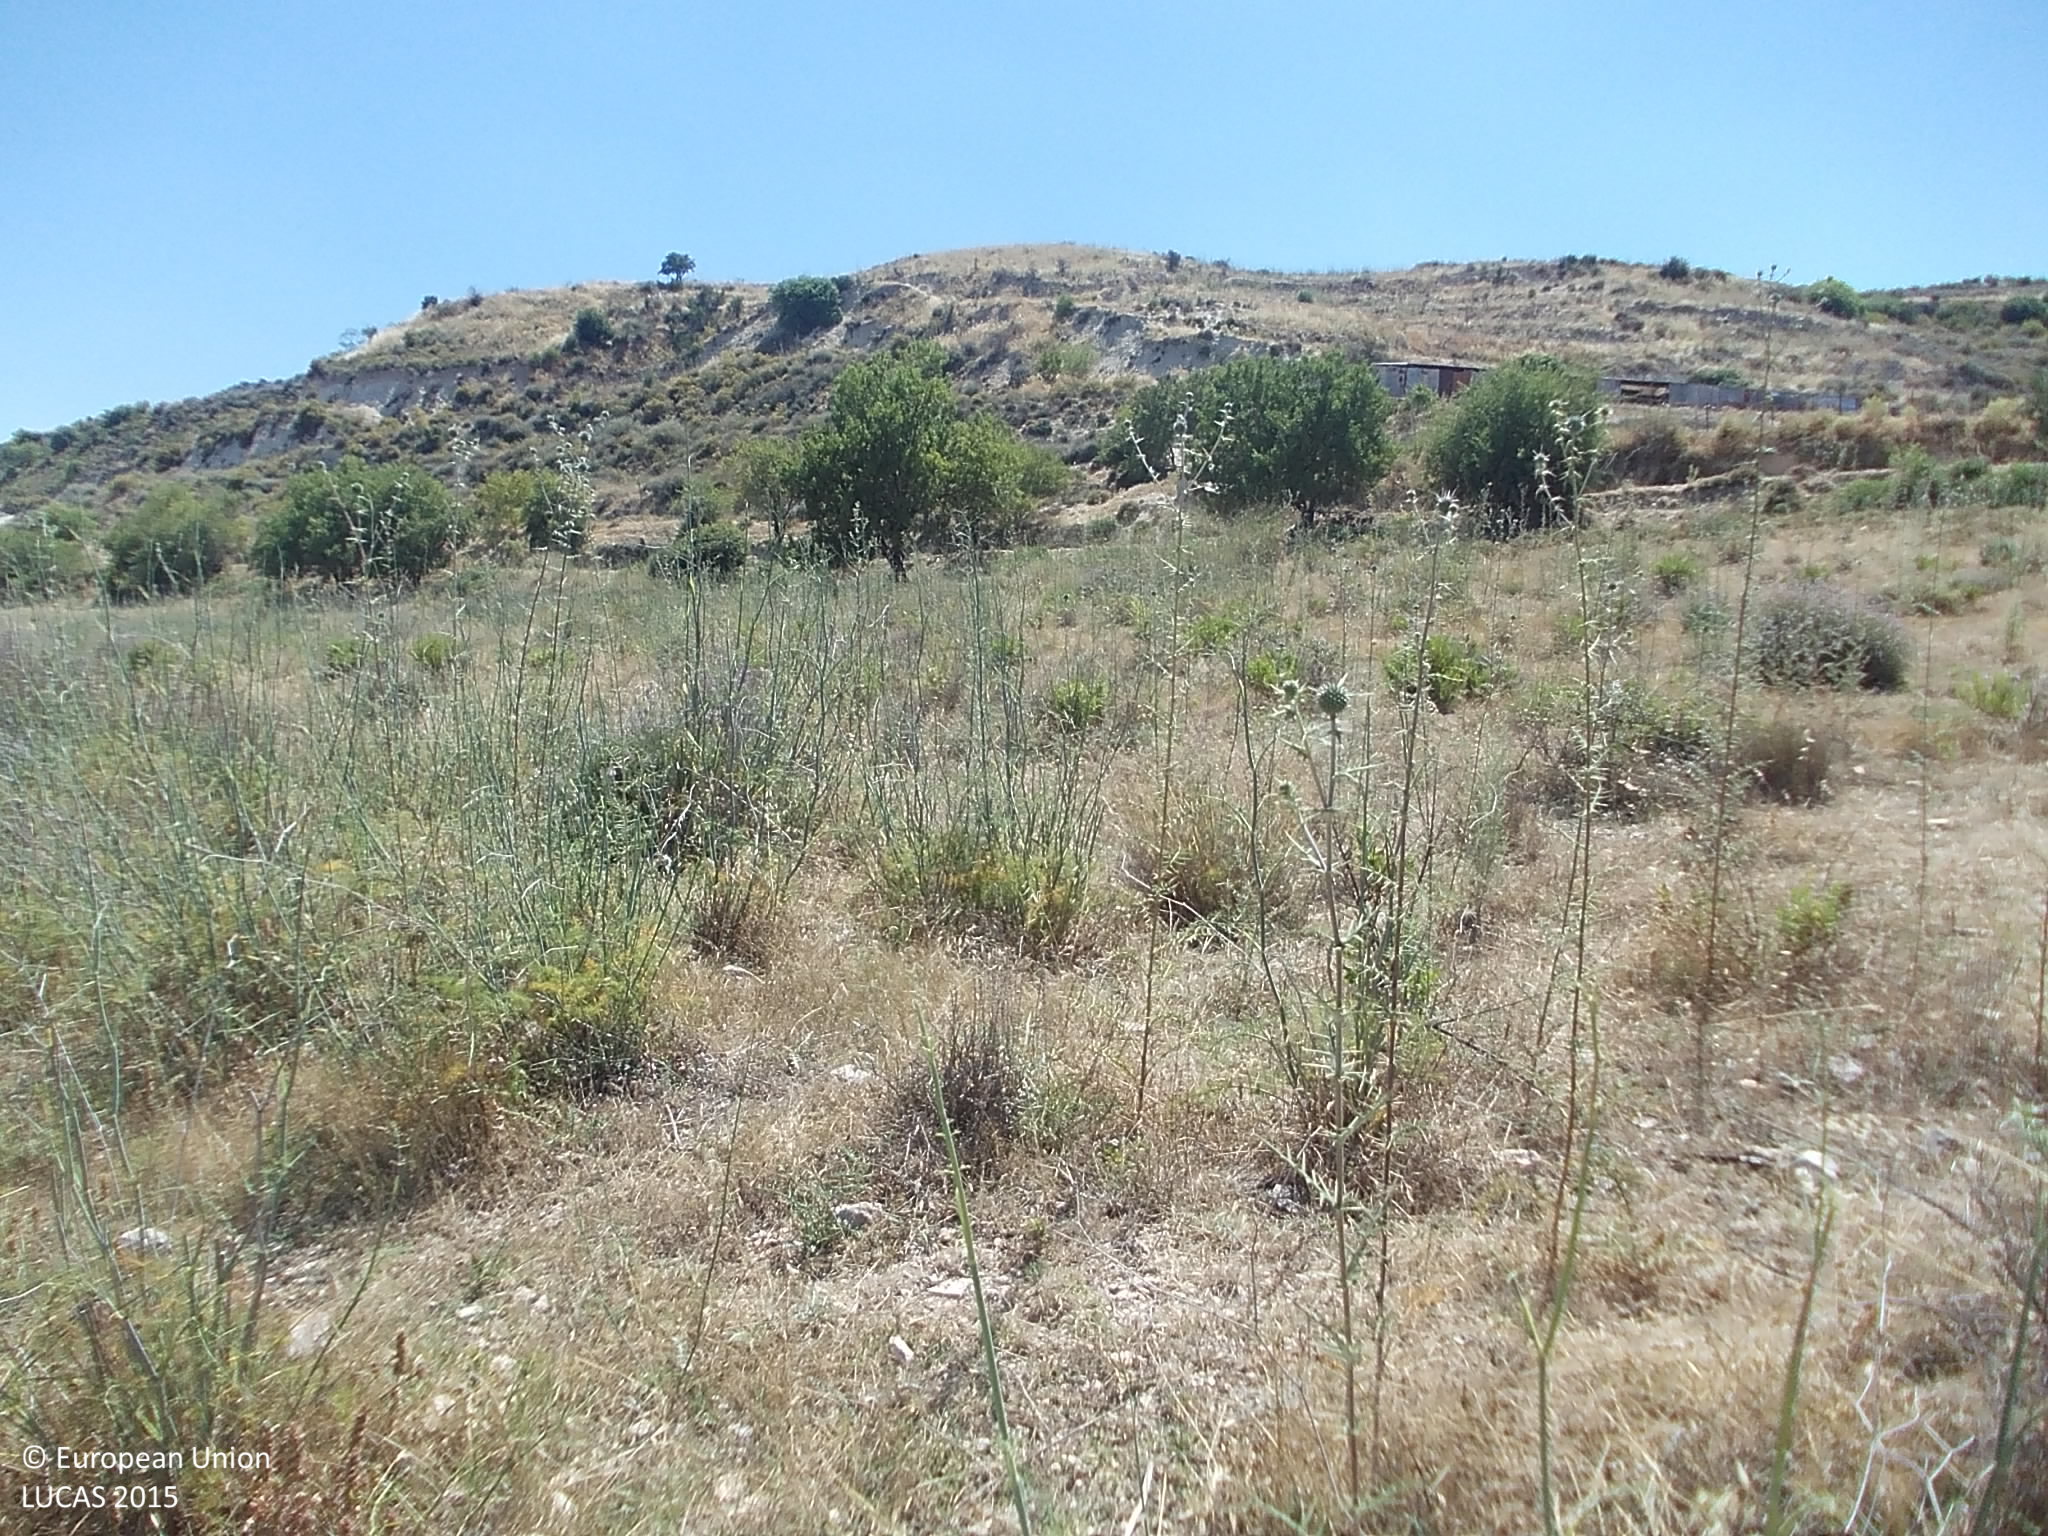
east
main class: Grassland
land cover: Grassland without tree/shrub cover
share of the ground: > 75 %
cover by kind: herbaceous plants 90 %, shrubs 5 %, unconsolidated bare surface 5 %
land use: Semi-natural and natural areas not in use
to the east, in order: Grassland without tree/shrub cover; Shrubland without tree cover; Lines of trees; Paved roads, cycling and walking lanes; Other bare soil; Paved roads, cycling and walking lanes; Grassland without tree/shrub cover; Fences; Shrubland without tree cover; Dry stone walls; Shrubland without tree cover; Dry stone walls; Shrubland without tree cover; Dry stone walls; Shrubland without tree cover; Dry stone walls; Shrubland without tree cover
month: July
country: CY
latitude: 34.8411
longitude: 32.7408
